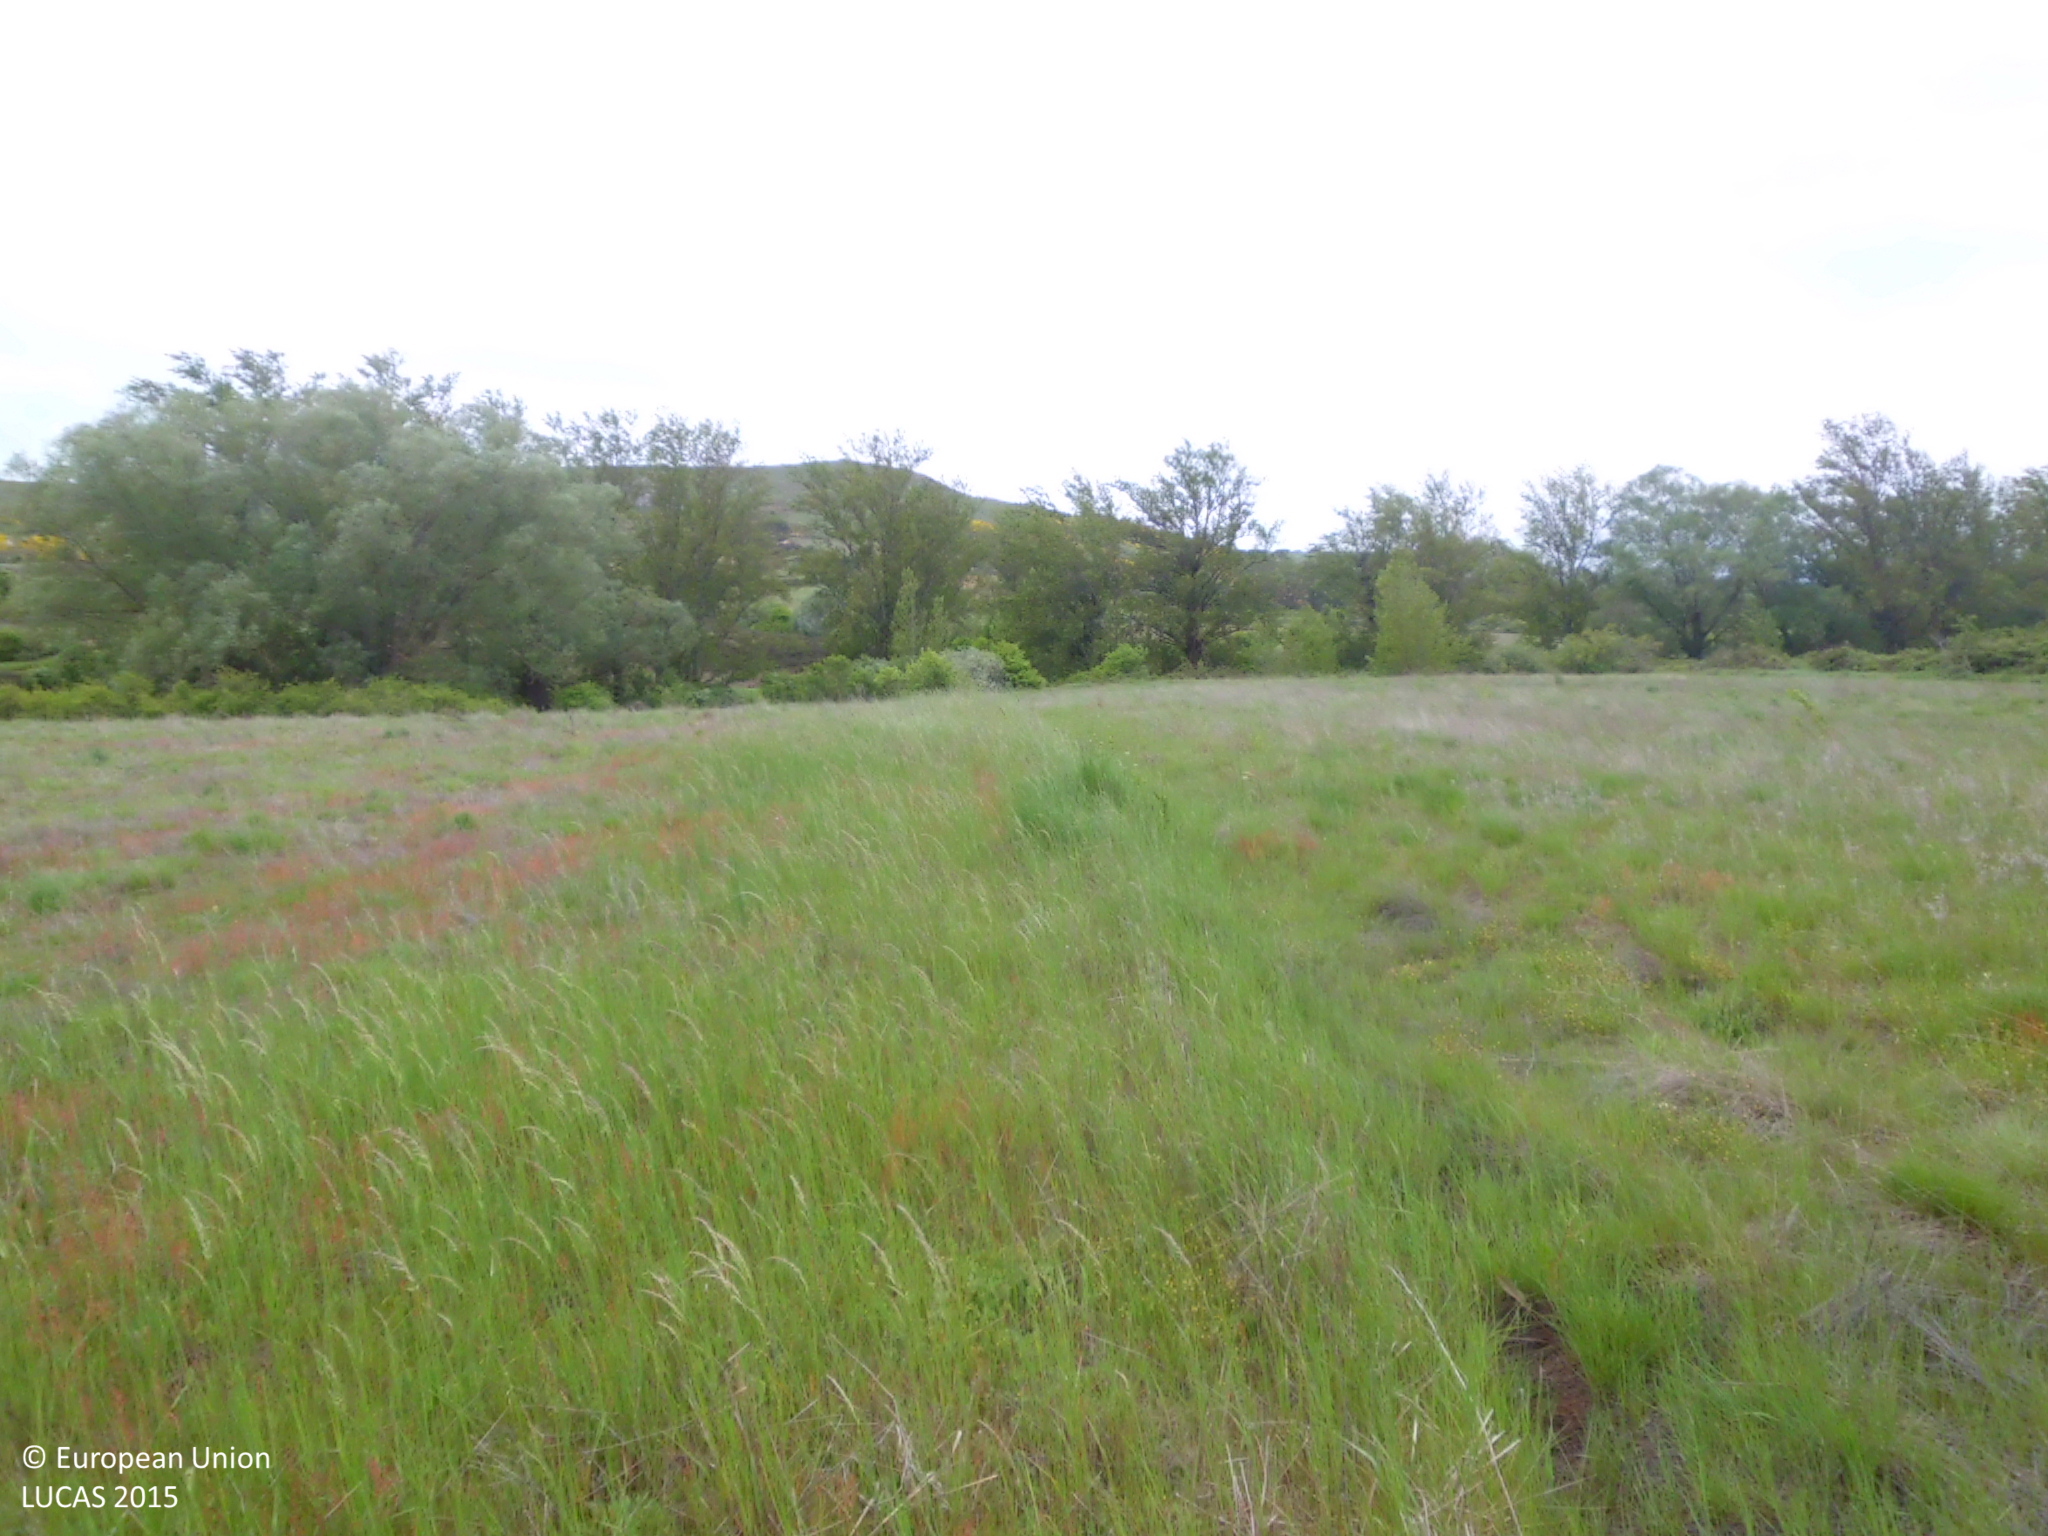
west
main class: Grassland
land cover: Grassland without tree/shrub cover
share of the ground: > 75 %
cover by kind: herbaceous plants 100 %
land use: Agriculture (excluding fallow land and kitchen gardens)
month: May
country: ES
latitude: 42.5840
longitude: -3.9208
